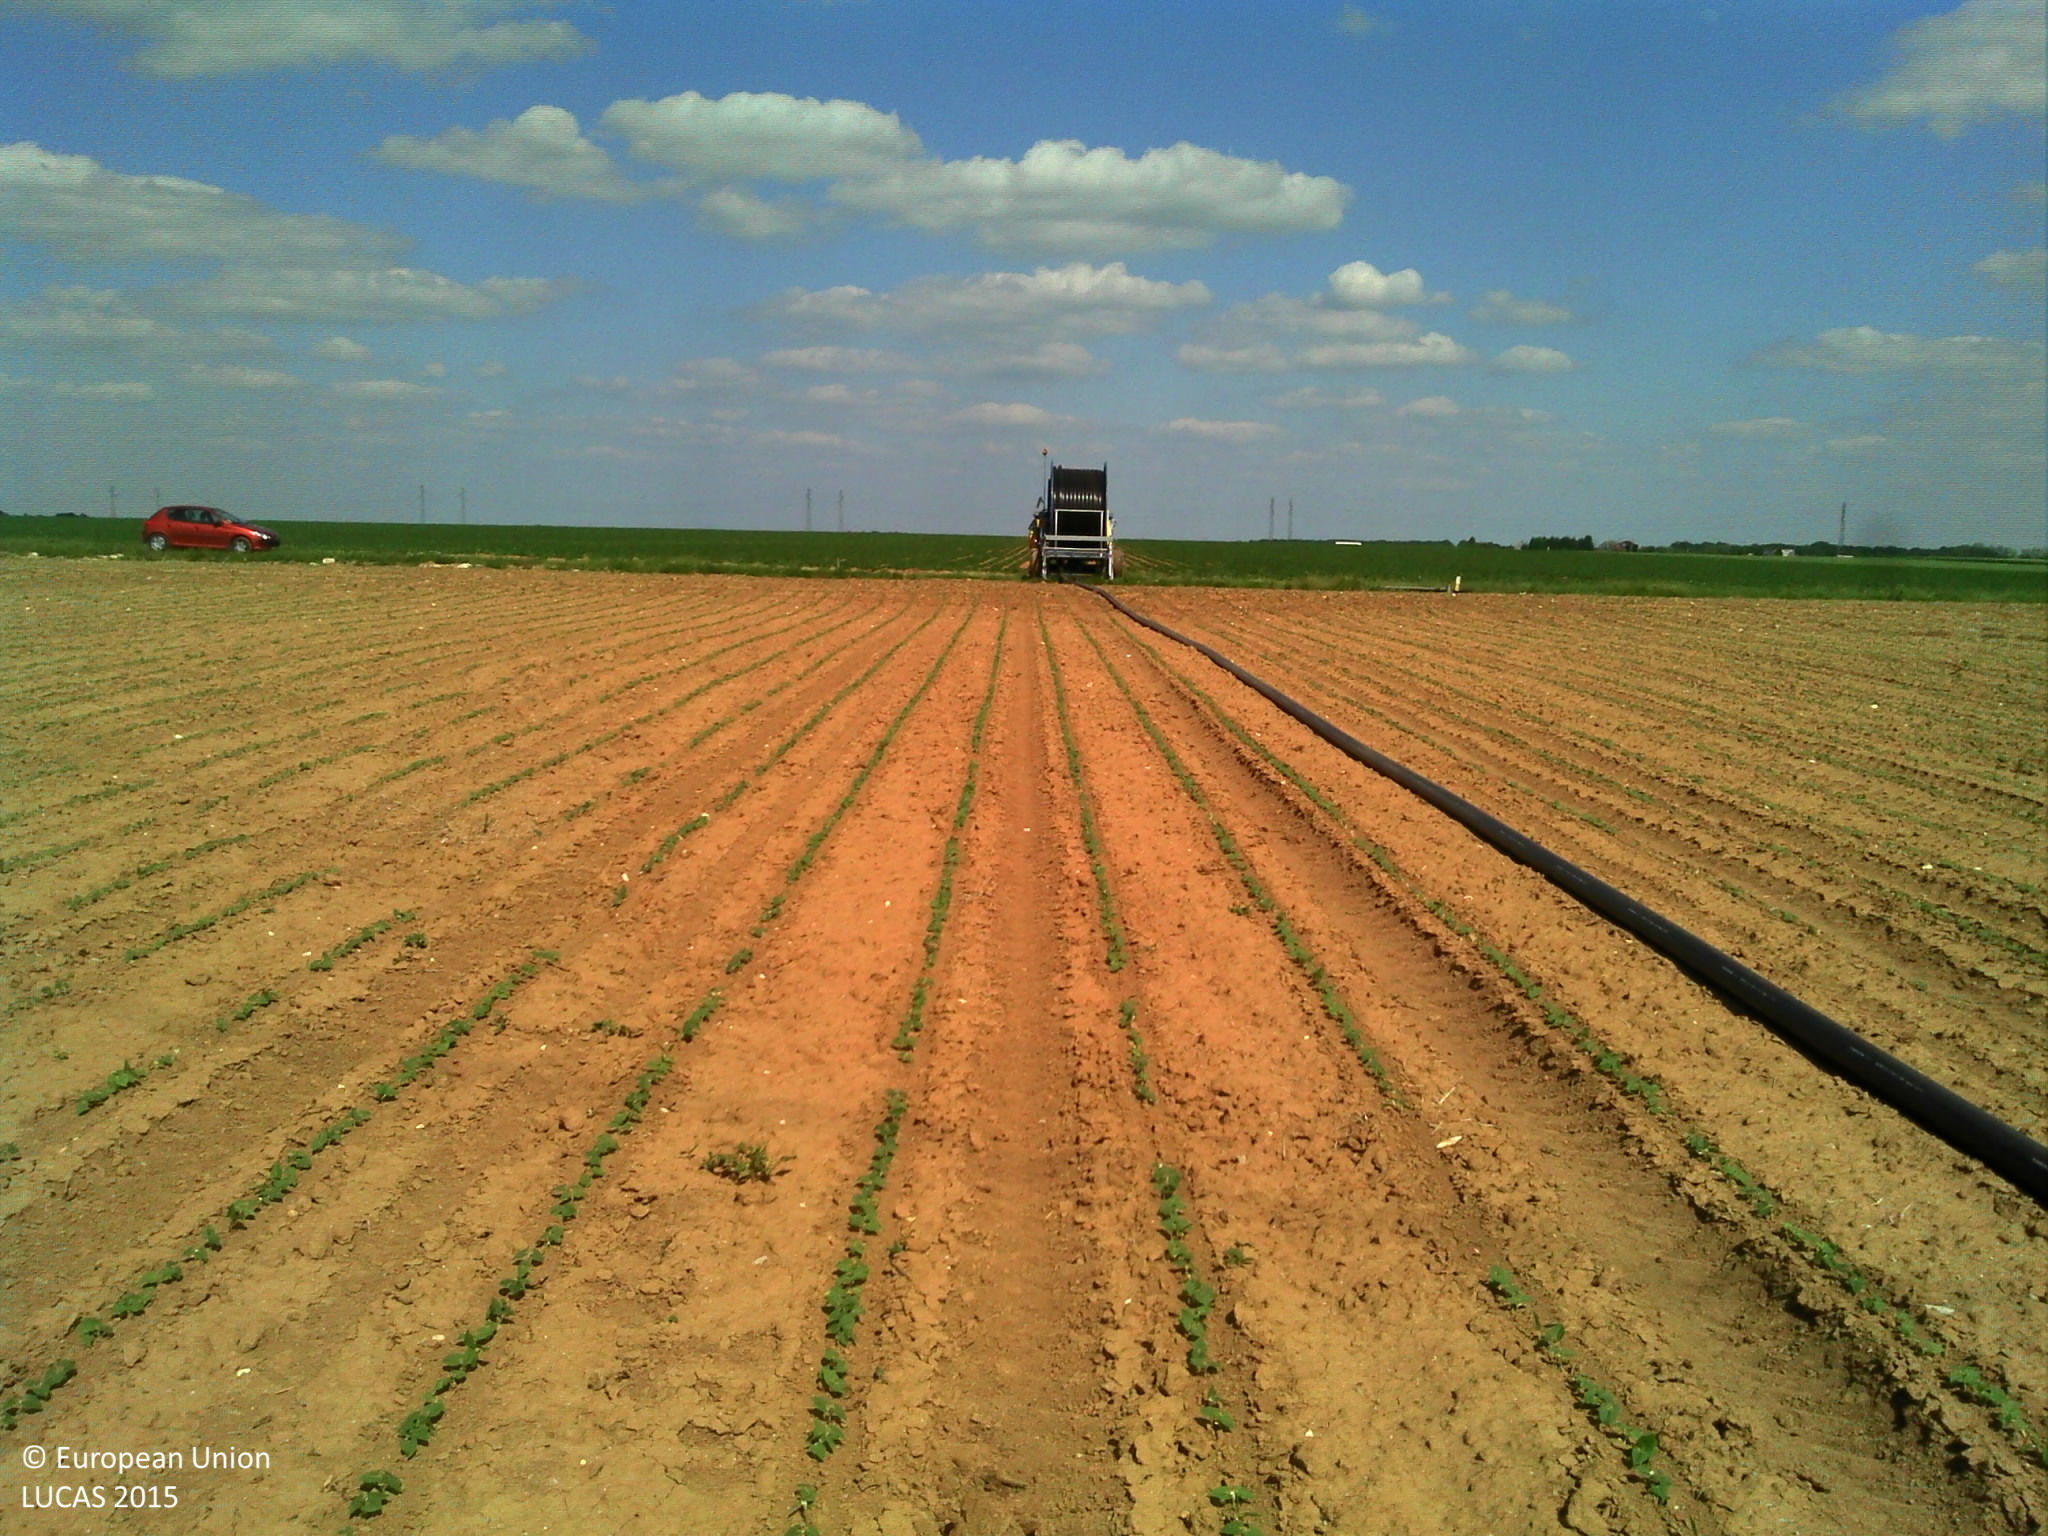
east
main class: Cropland
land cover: Dry pulses
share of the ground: 25 - 50 %
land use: Agriculture (excluding fallow land and kitchen gardens)
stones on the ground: < 10 %
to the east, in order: Dry pulses; Tracks; Potatoes
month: May
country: FR
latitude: 48.2917
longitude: 1.9670
